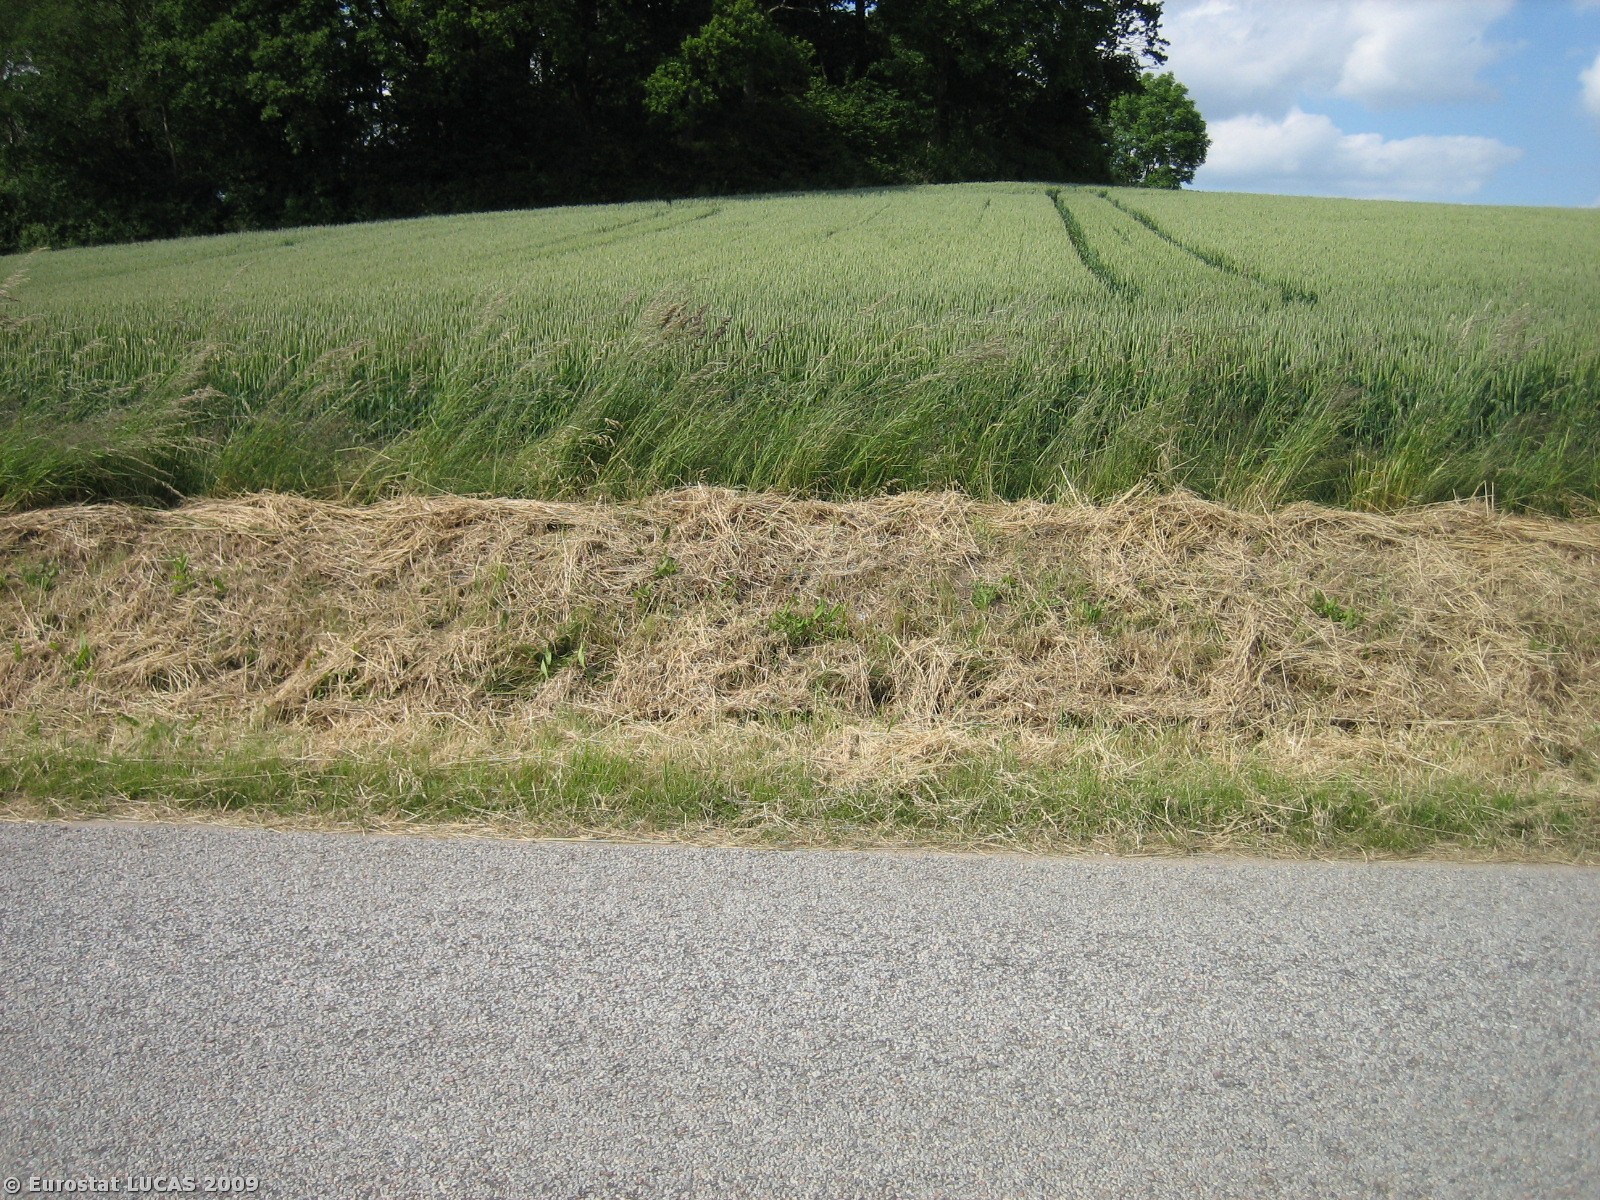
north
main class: Cropland
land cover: Rape and turnip rape
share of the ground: > 75 %
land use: Agriculture (excluding fallow land and kitchen gardens)
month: June
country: DK
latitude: 55.7563
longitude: 9.9841
